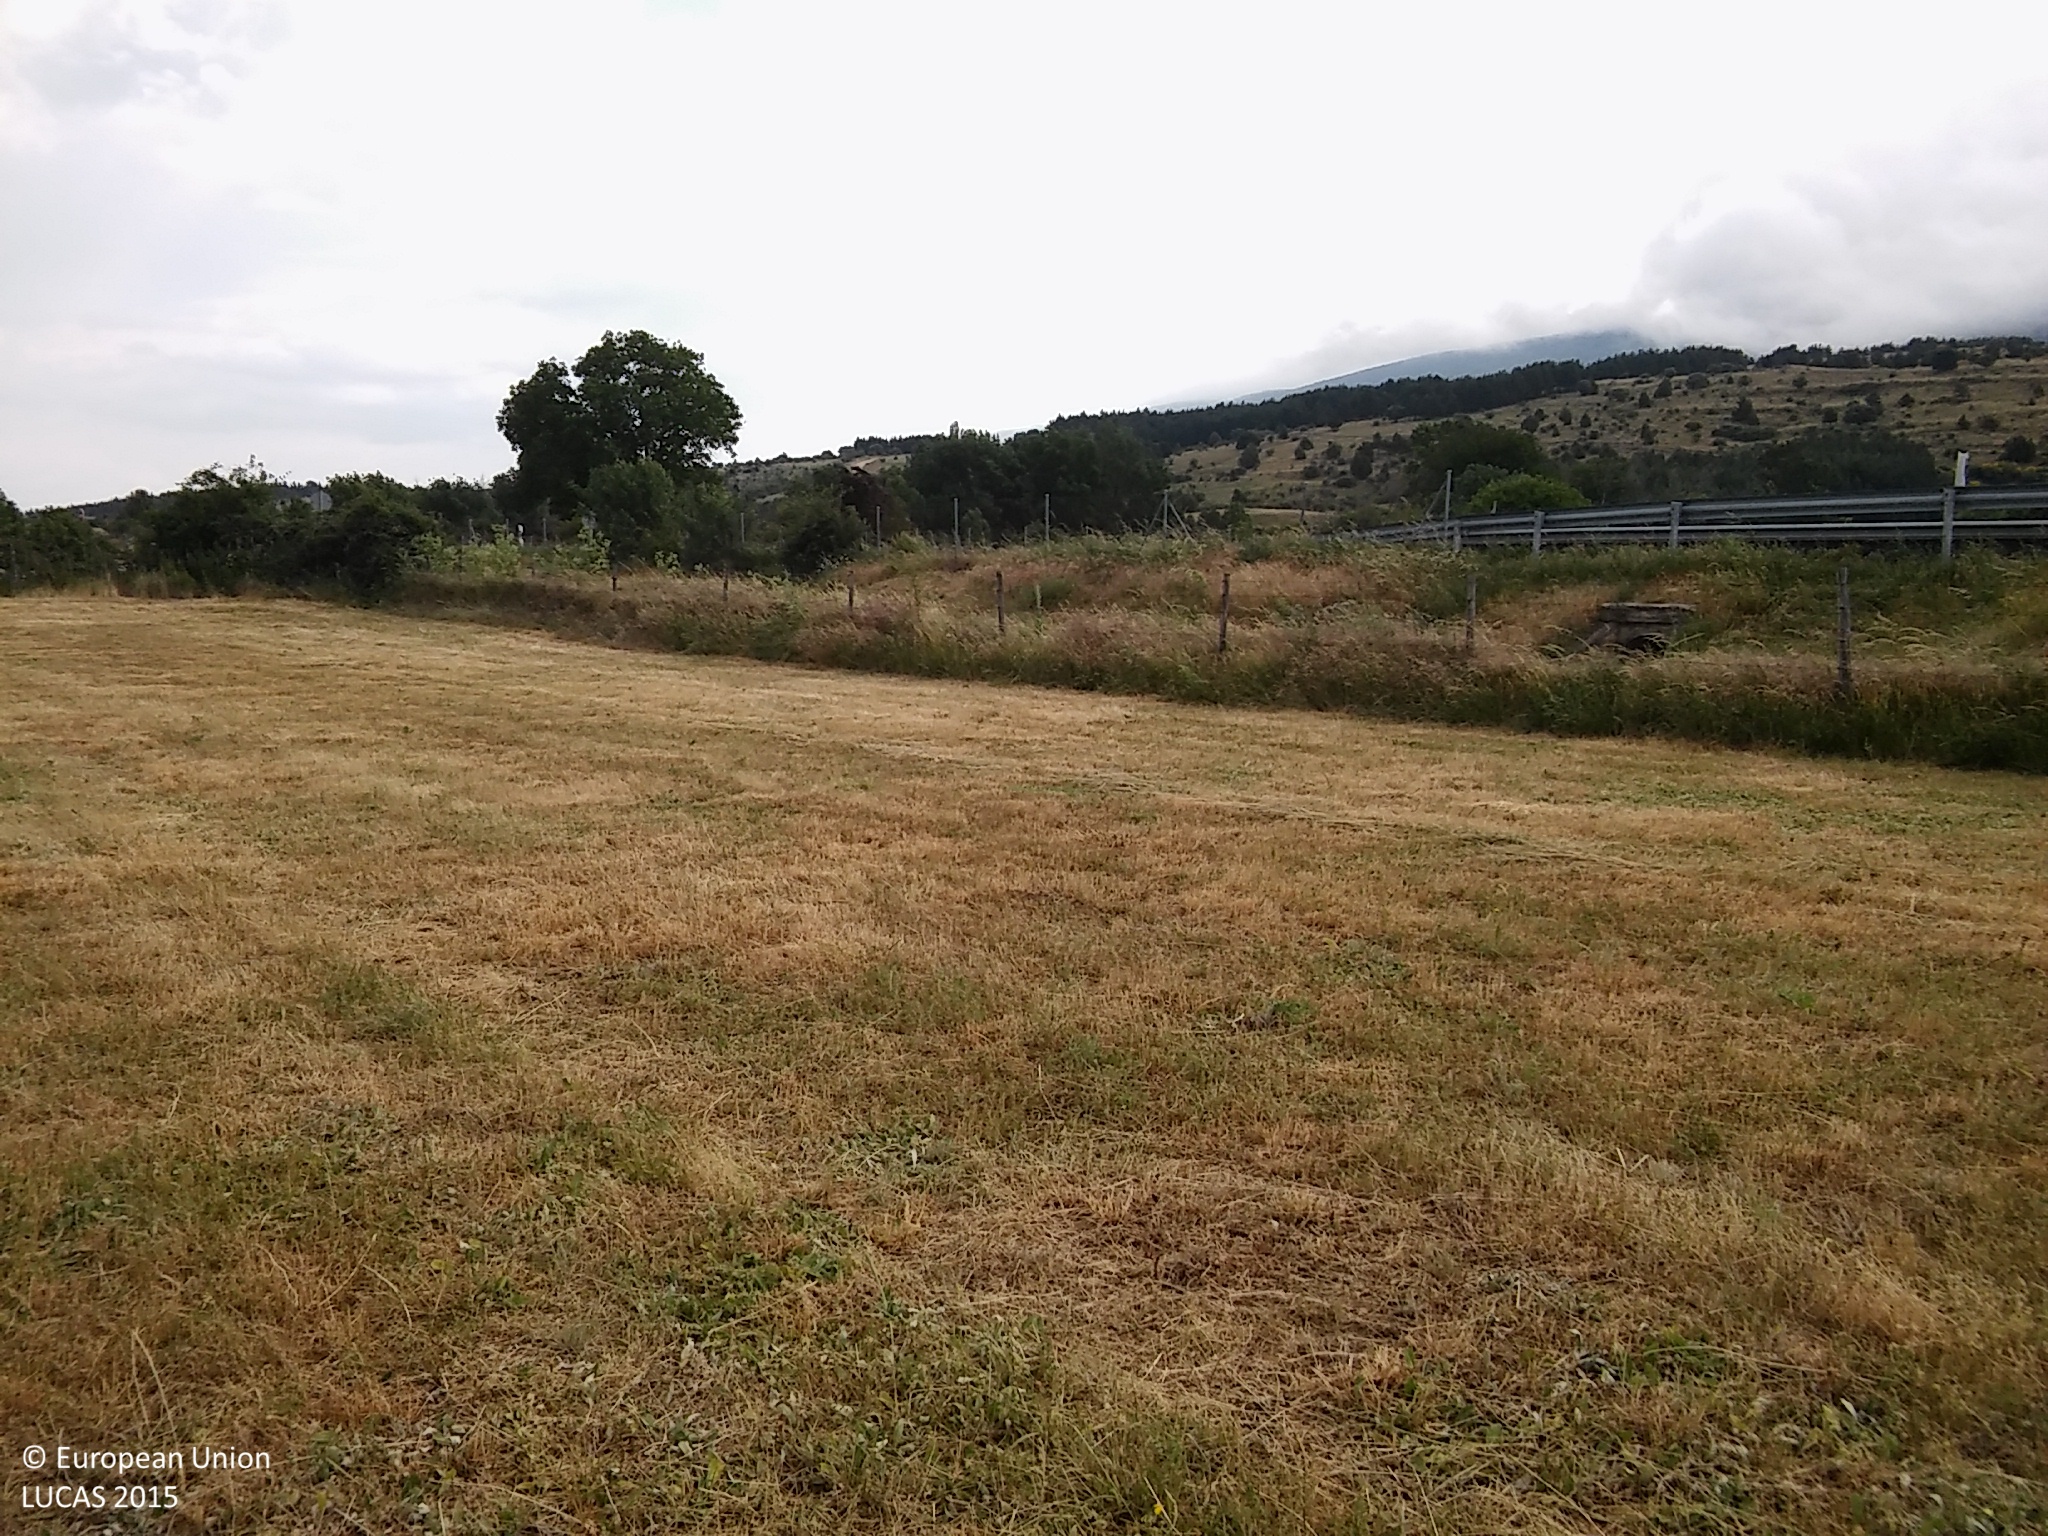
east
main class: Grassland
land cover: Grassland without tree/shrub cover
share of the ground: > 75 %
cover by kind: herbaceous plants 100 %
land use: Agriculture (excluding fallow land and kitchen gardens)
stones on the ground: 10 - 25 %
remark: Harvested field
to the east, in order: Grassland without tree/shrub cover; Fences; Grass margins; Tracks; Spontaneously vegetated surfaces; Paved roads, cycling and walking lanes; Grass margins; Ditches and canals; Grassland without tree/shrub cover; Tracks; Dry stone walls; Grassland without tree/shrub cover; Abandoned hedges; Dry stone walls; Grassland without tree/shrub cover; Dry stone walls; Abandoned hedges; Grassland without tree/shrub cover; Tomatoes; Dry stone walls; Broadleaved woodland; Dry stone walls; Tomatoes; Broadleaved woodland; Dry stone walls; Spontaneously vegetated surfaces; Tracks; Grassland without tree/shrub cover; Artificial constructions in urban areas; Grass margins; Dry stone walls; Abandoned hedges; Grassland without tree/shrub cover
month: June
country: ES
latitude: 41.1345
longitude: -3.6864
